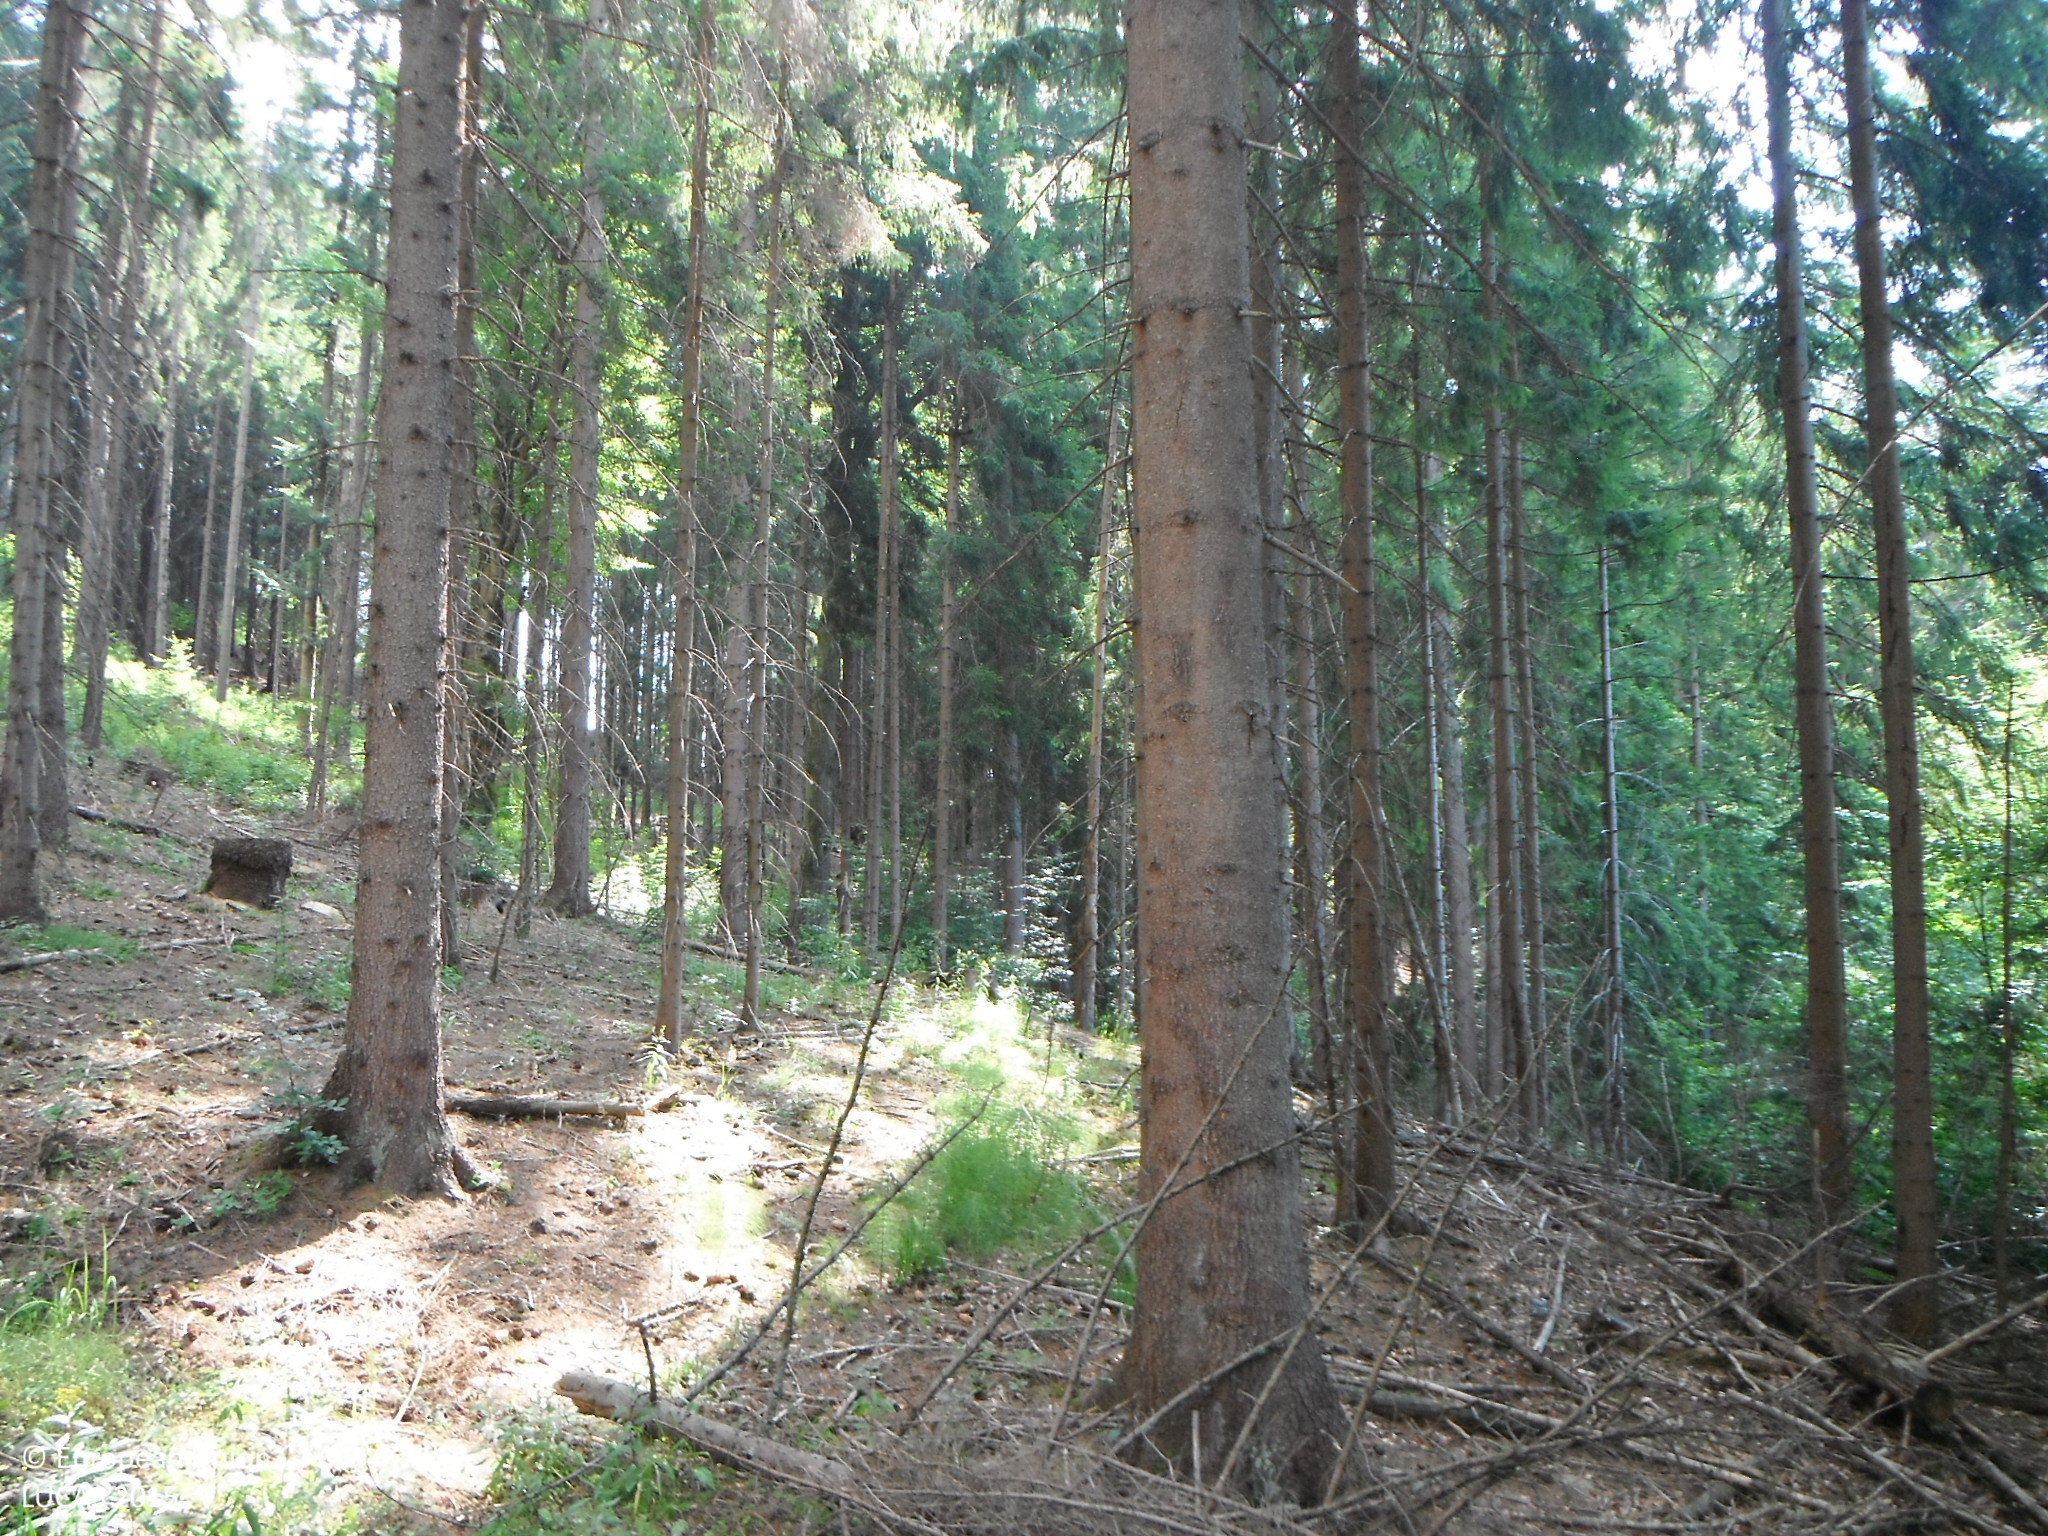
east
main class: Woodland
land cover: Spruce dominated coniferous woodland
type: alpine coniferous forest
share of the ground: > 75 %
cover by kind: coniferous forest trees 100 %
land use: Forestry
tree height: > 5 m
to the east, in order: Spruce dominated coniferous woodland; Other coniferous woodland; Tracks; Other coniferous woodland; Spruce dominated mixed woodland
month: July
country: SK
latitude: 49.3496
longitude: 19.0945
